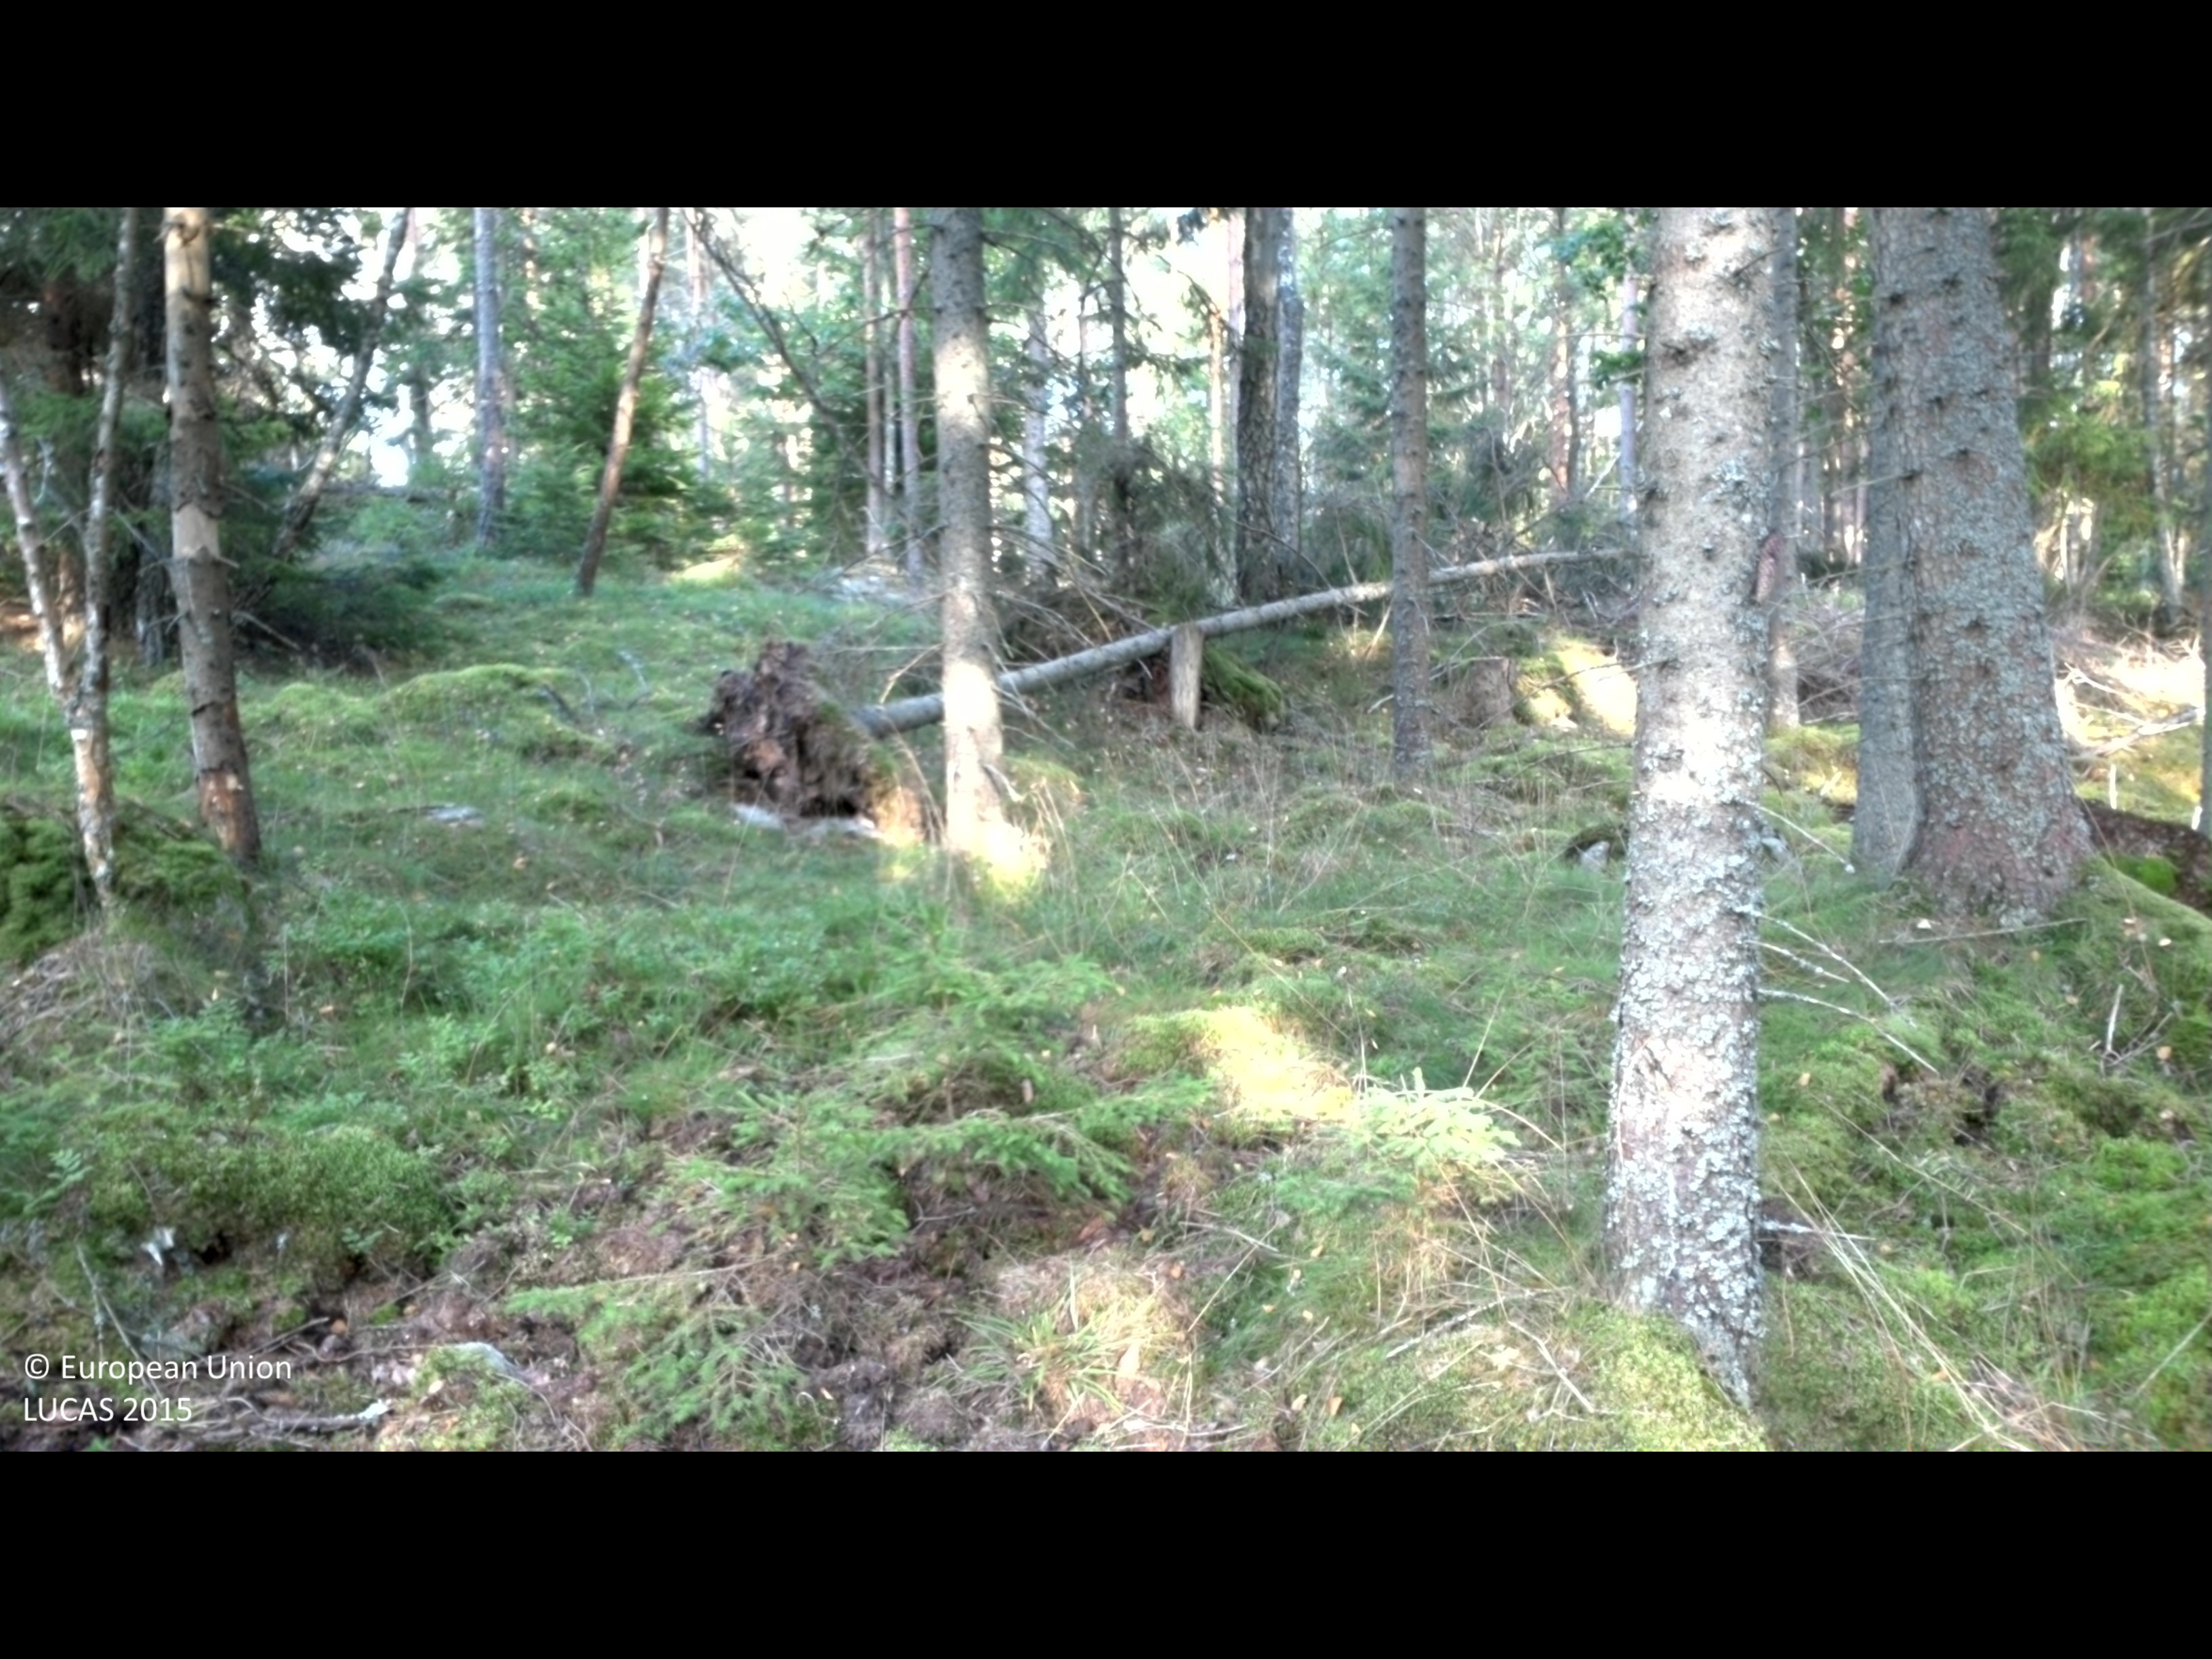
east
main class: Woodland
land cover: Spruce dominated coniferous woodland
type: boreal forest
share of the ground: 50 - 75 %
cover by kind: coniferous forest trees 55 %, lichens and mosses 35 %, shrubs 10 %
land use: Forestry
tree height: > 5 m
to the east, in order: Spruce dominated coniferous woodland; Pine dominated coniferous woodland; Spruce dominated coniferous woodland
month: August
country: SE
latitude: 56.3449
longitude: 14.4470
